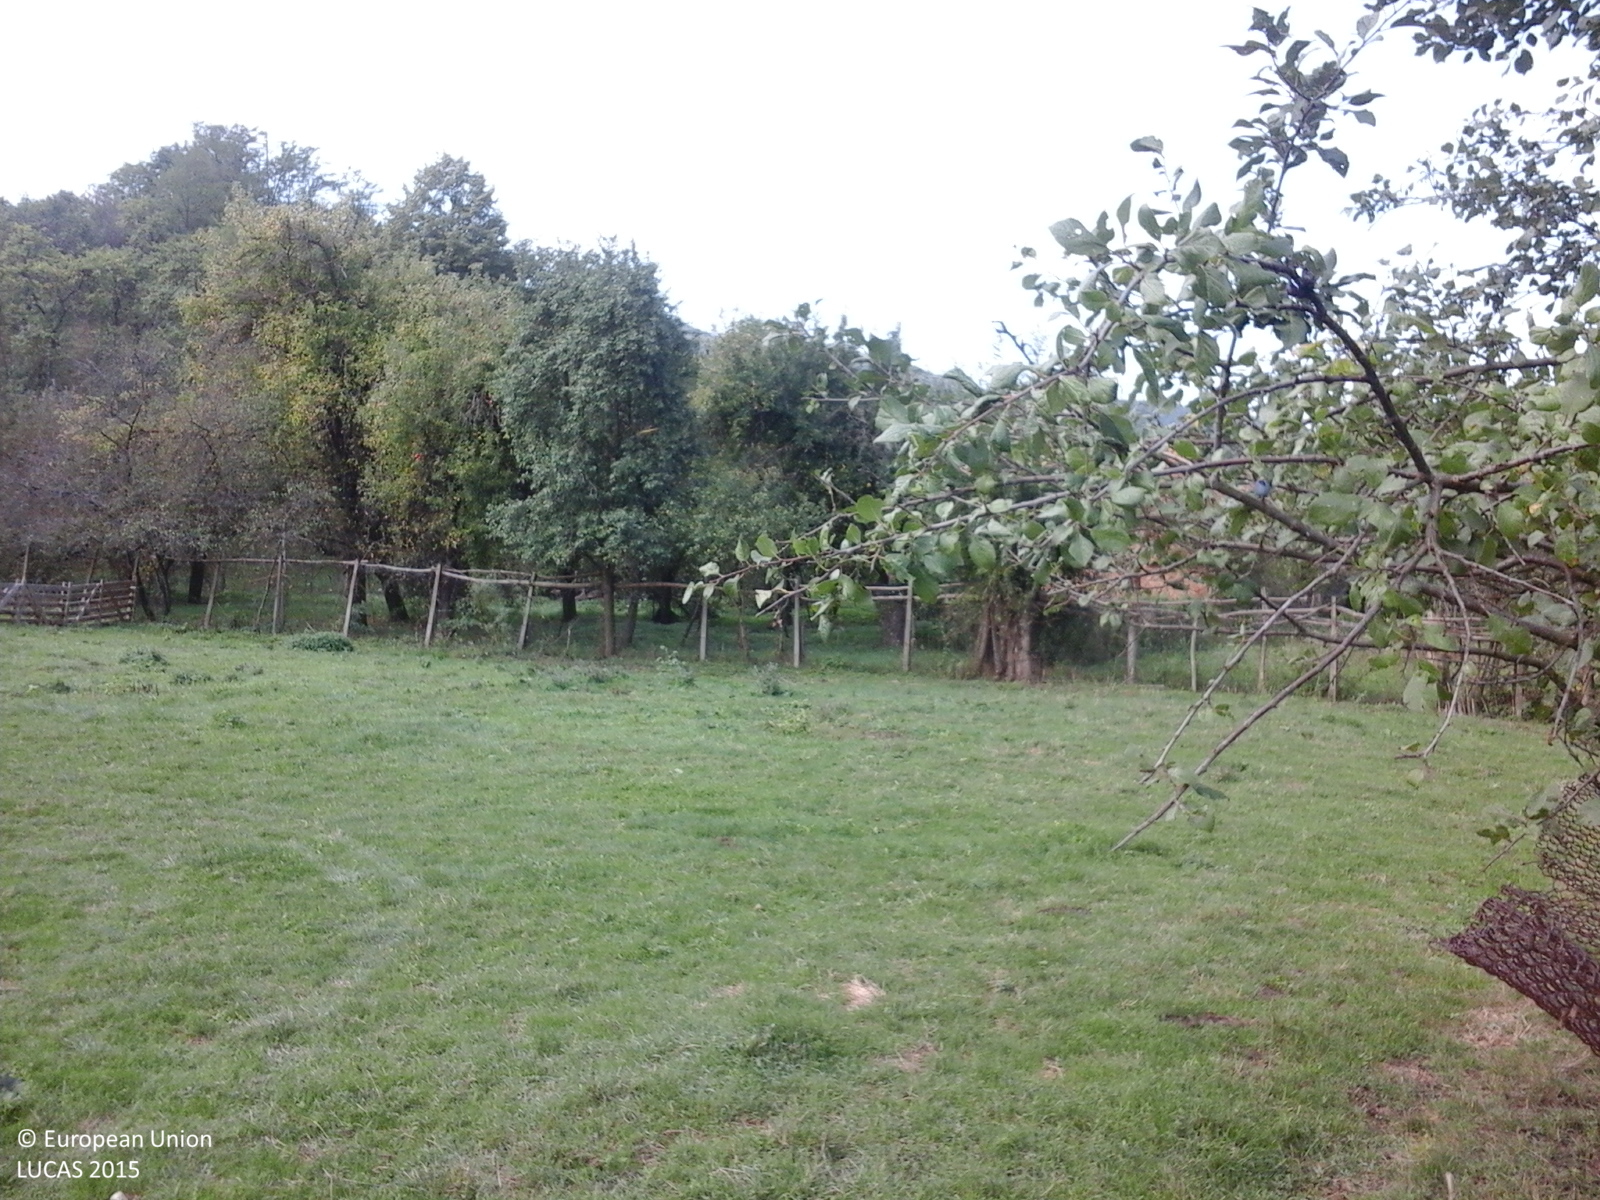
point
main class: Grassland
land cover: Grassland without tree/shrub cover
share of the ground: > 75 %
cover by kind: herbaceous plants 100 %
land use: Agriculture (excluding fallow land and kitchen gardens)
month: September
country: RO
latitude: 45.5783
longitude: 22.8017
